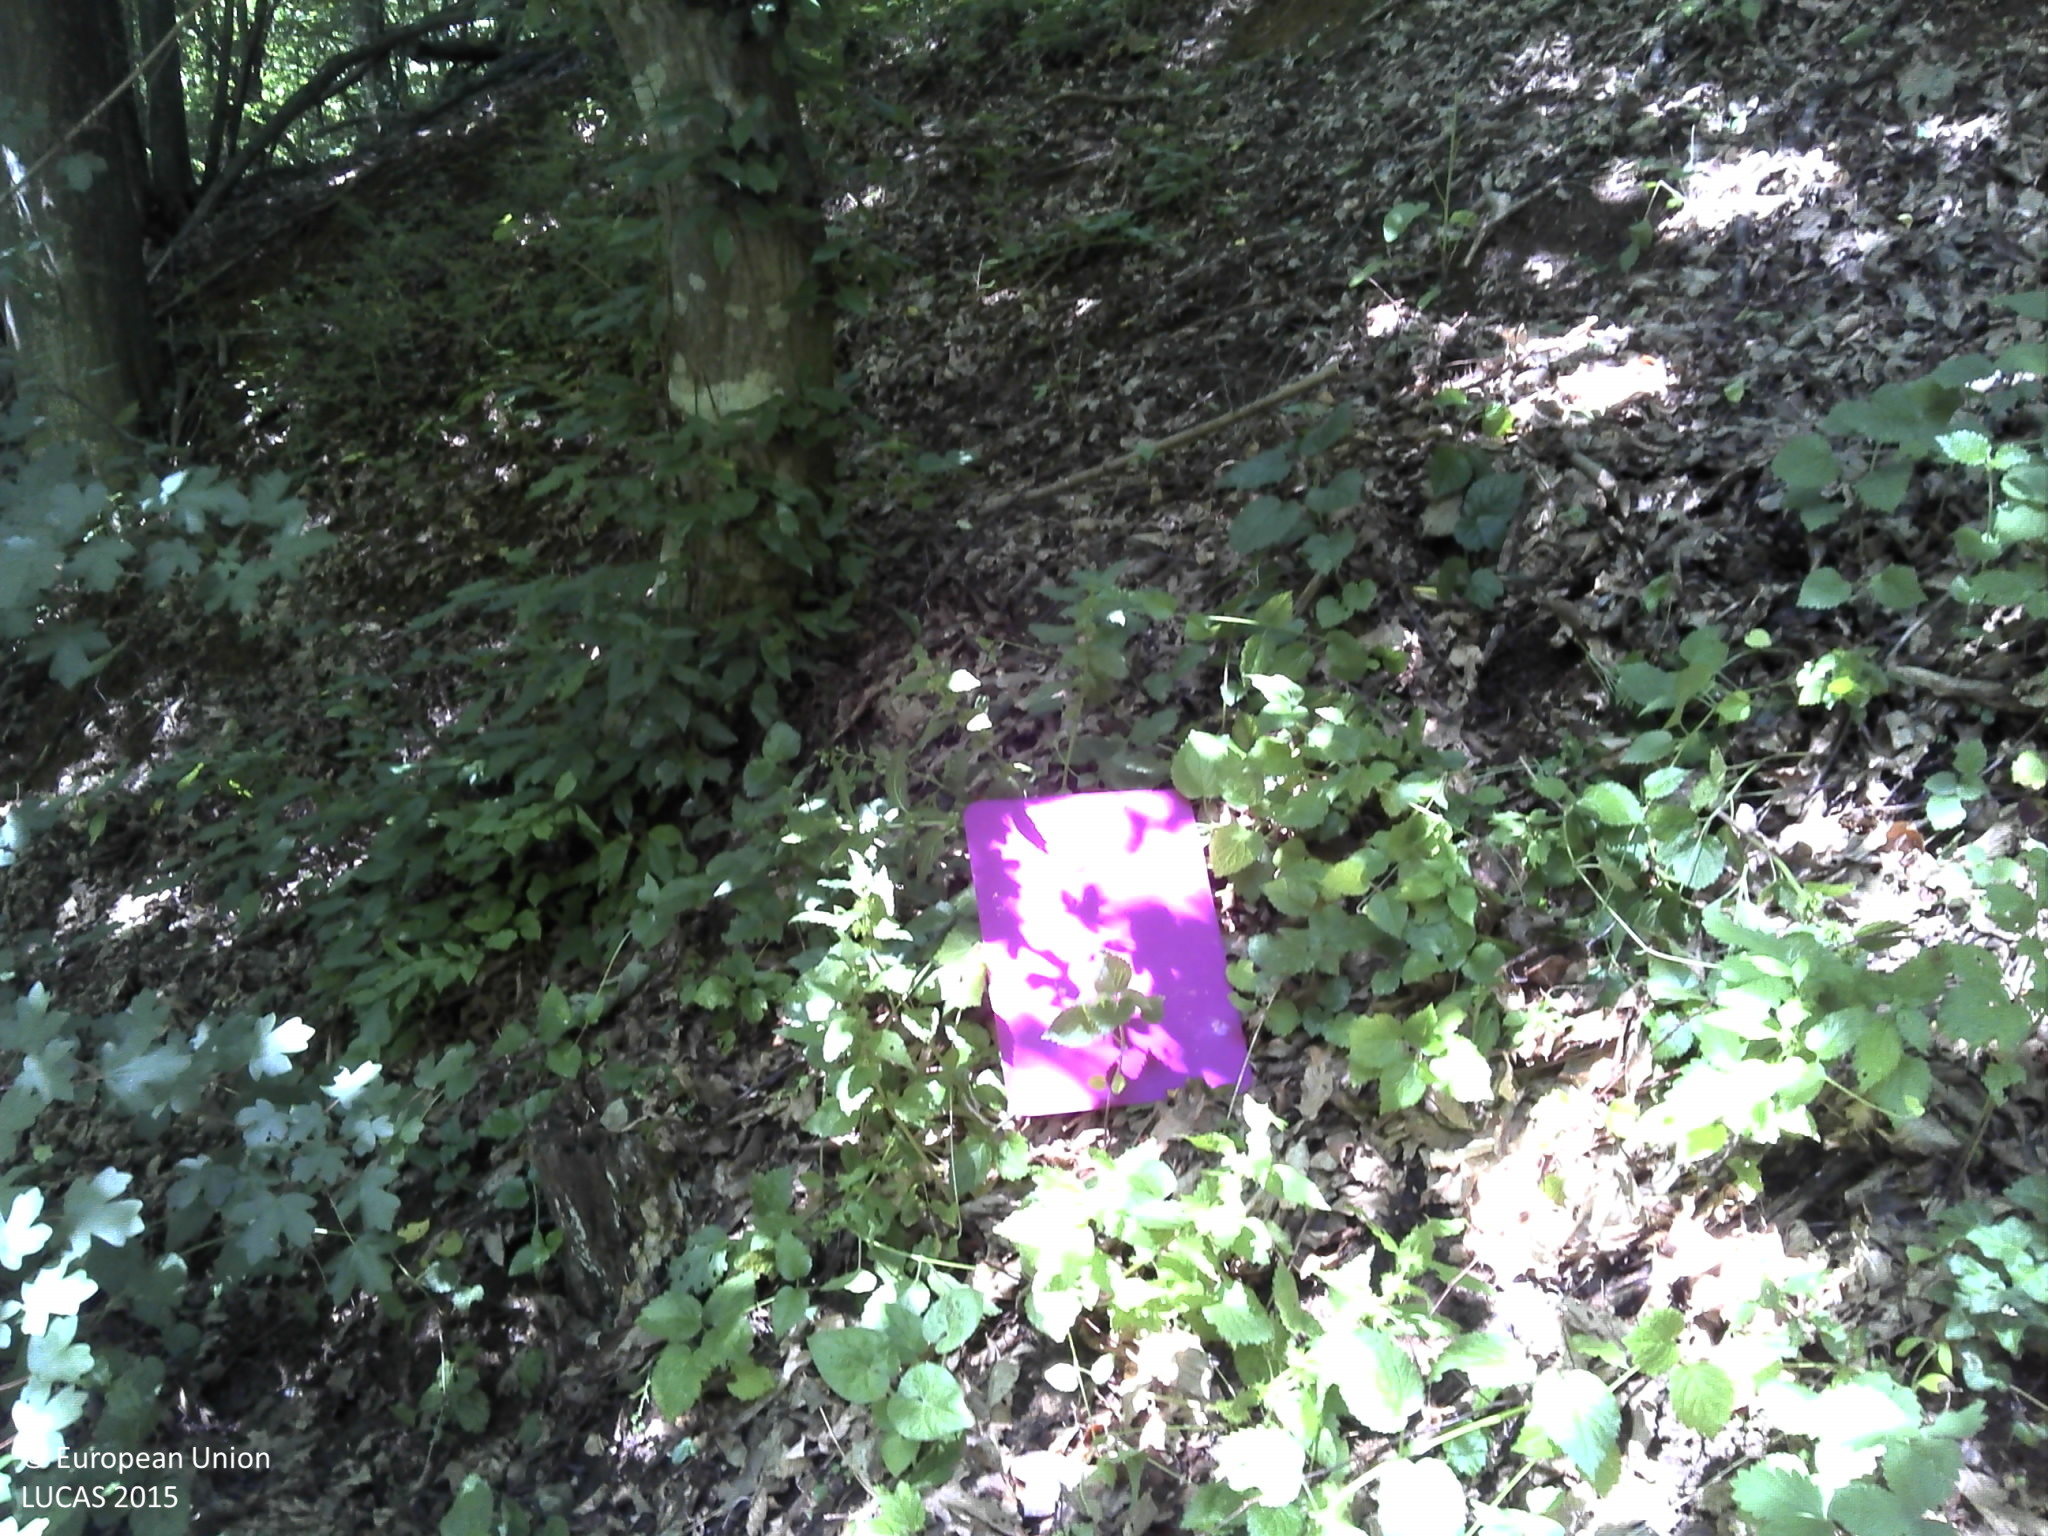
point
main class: Woodland
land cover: Broadleaved woodland
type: beech forest
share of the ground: > 75 %
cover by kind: broadleaved forest trees 100 %
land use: Forestry
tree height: > 5 m
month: May
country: HR
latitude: 45.3986
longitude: 18.0131
